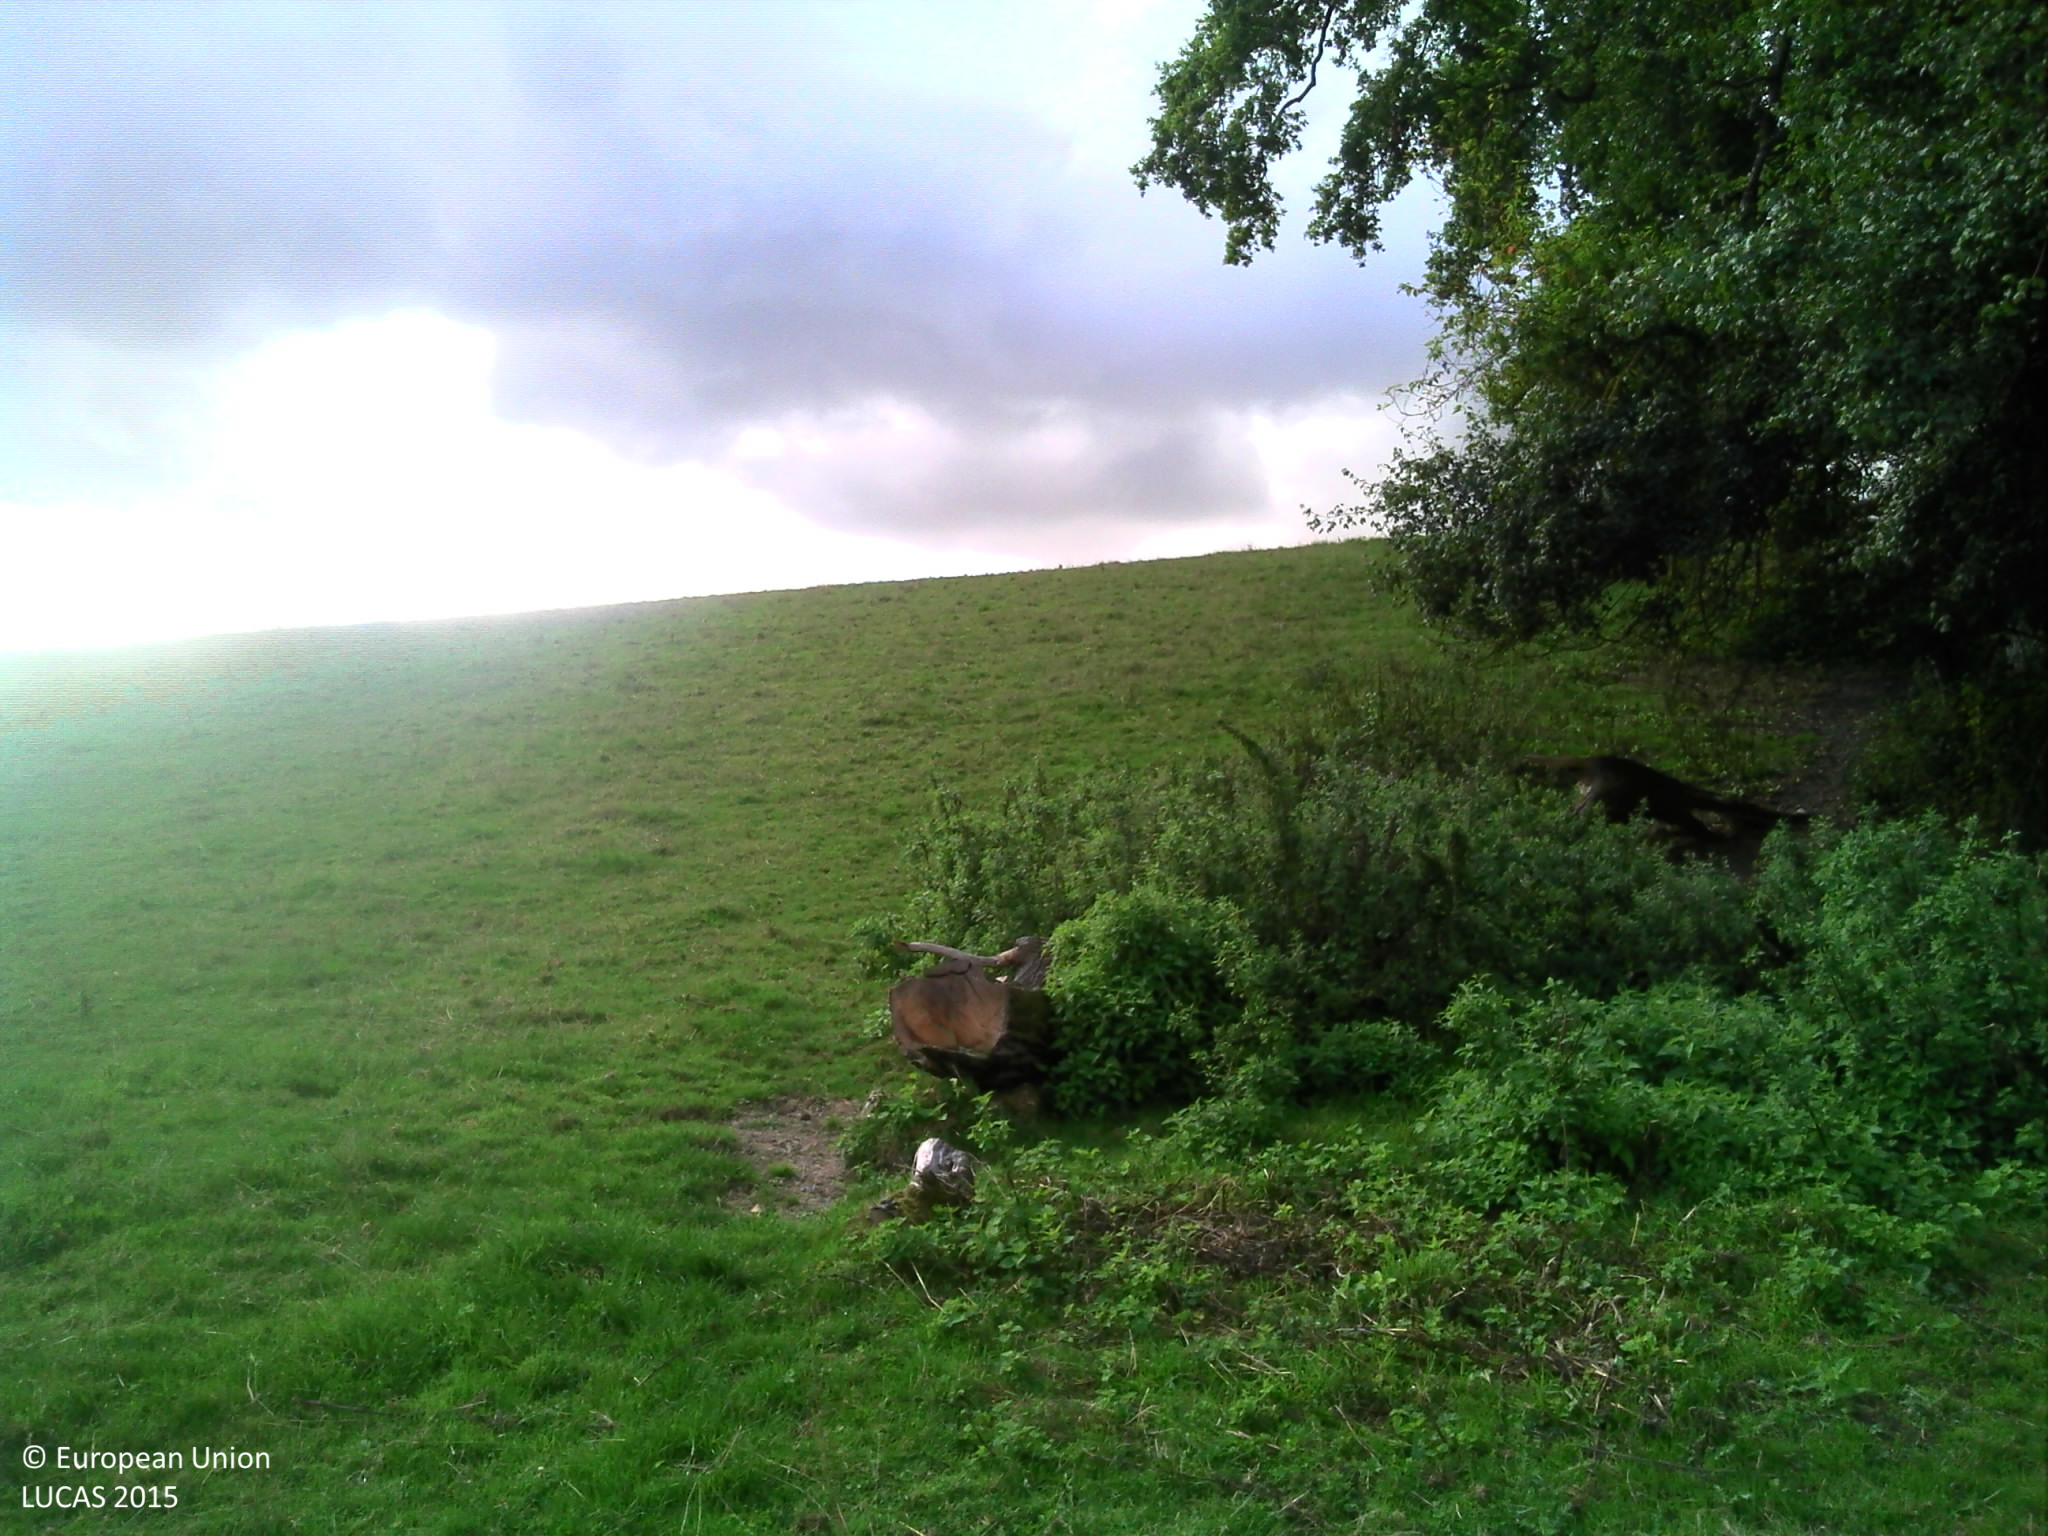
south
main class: Cropland
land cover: Maize
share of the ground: > 75 %
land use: Agriculture (excluding fallow land and kitchen gardens)
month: September
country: FR
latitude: 48.4001
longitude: 0.8067
